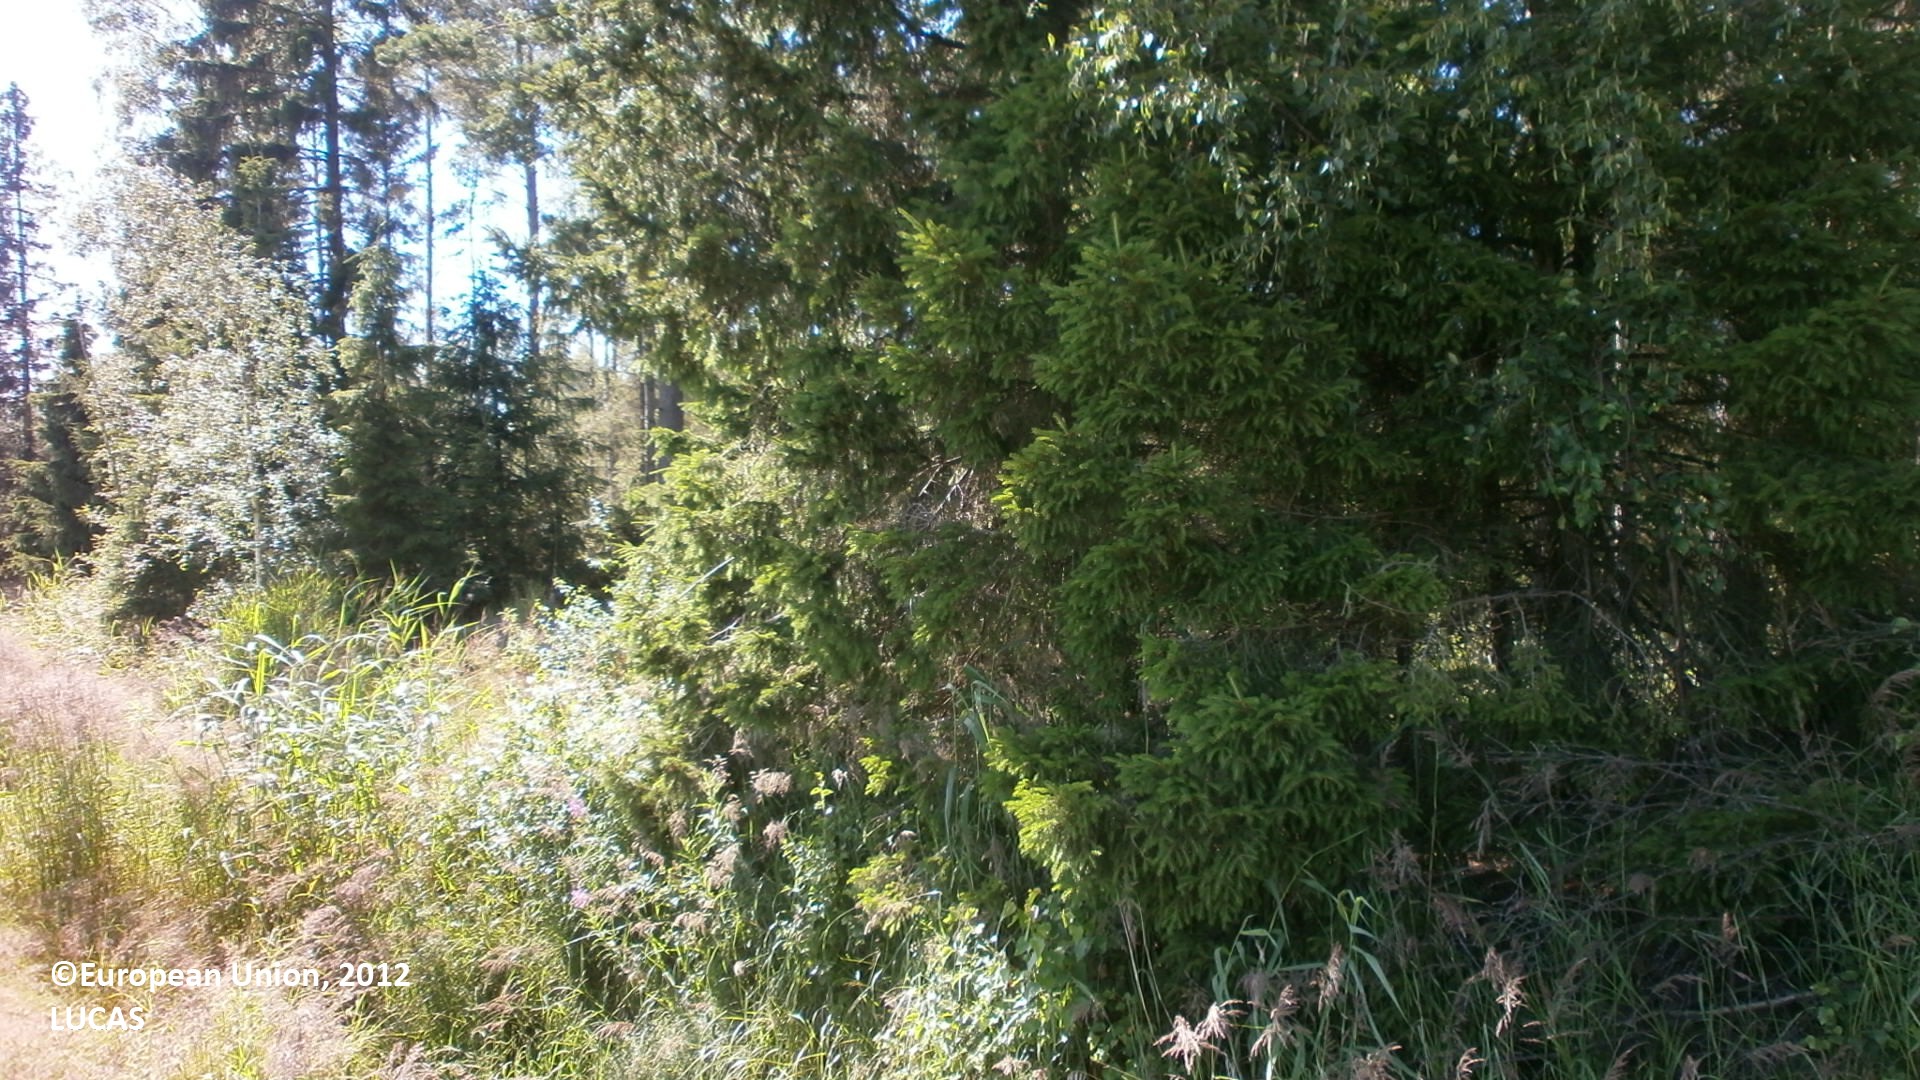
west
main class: Cropland
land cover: Barley
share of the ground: > 75 %
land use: Agriculture (excluding fallow land and kitchen gardens)
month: July
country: FI
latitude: 64.2954
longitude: 23.9267
